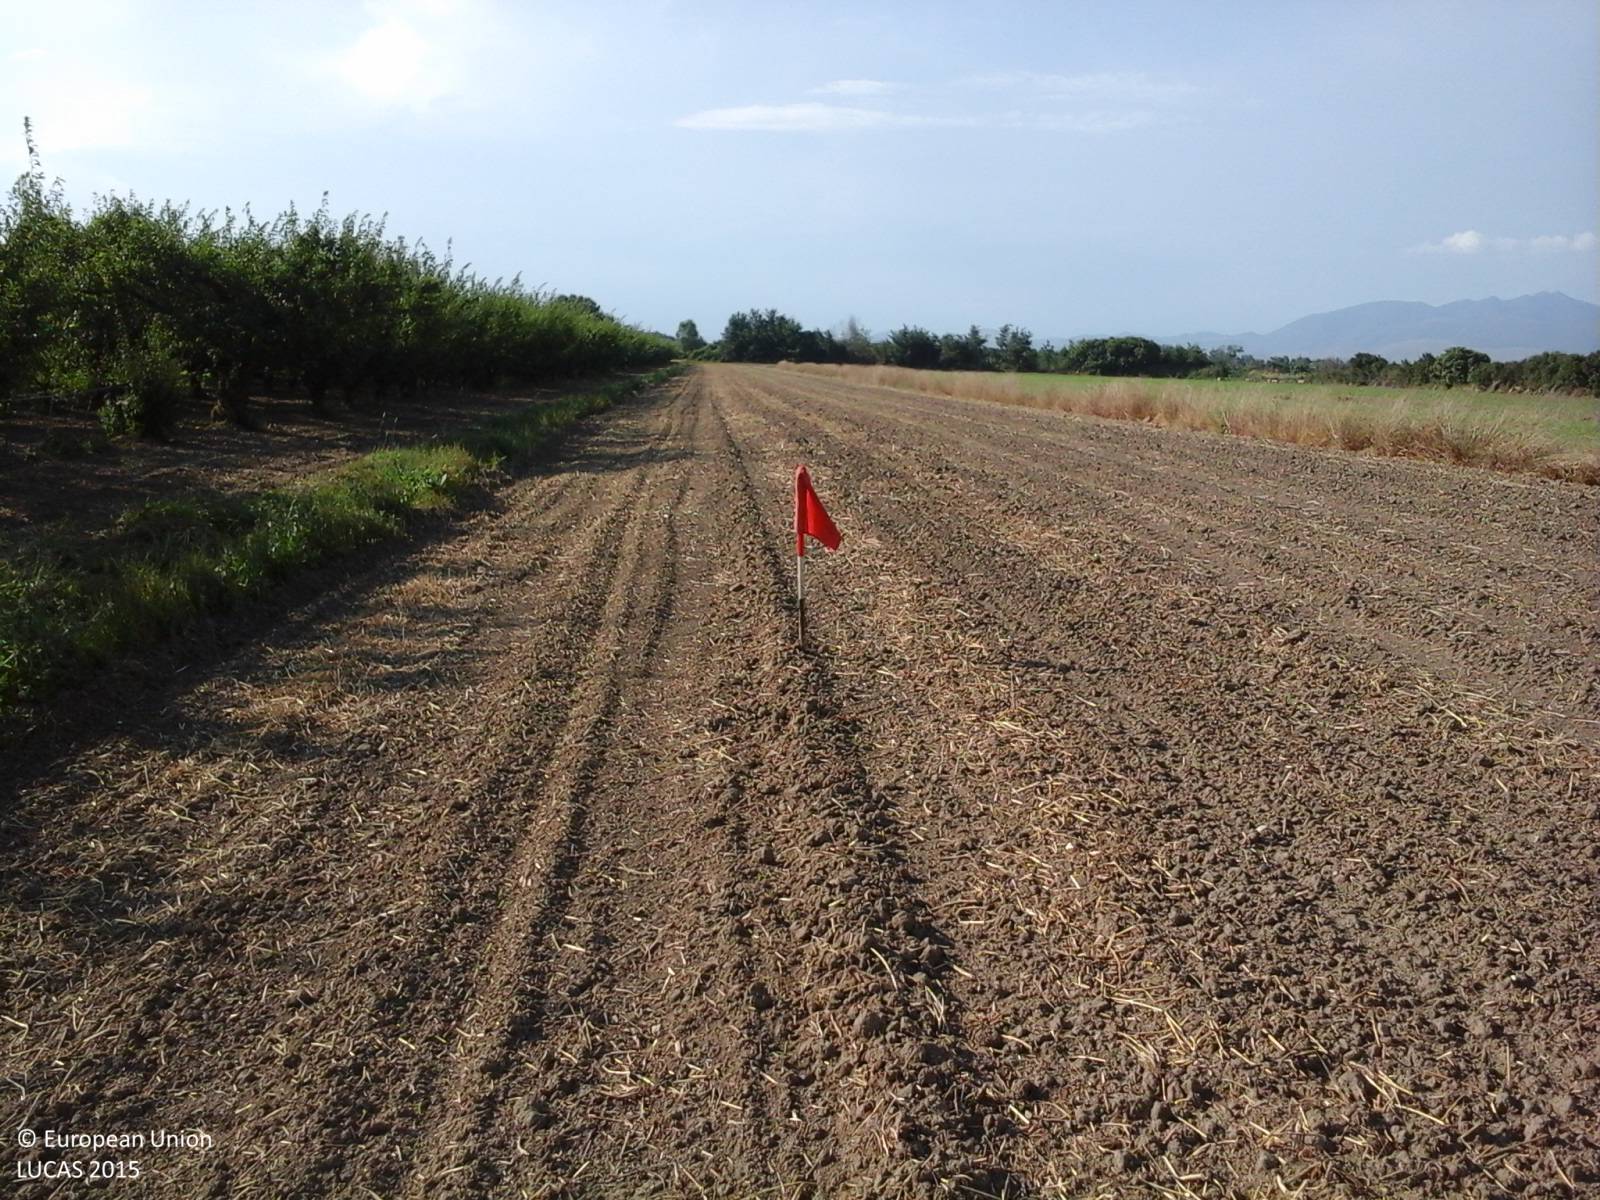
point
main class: Cropland
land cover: Temporary grasslands
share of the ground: < 10 %
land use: Agriculture (excluding fallow land and kitchen gardens)
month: June
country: IT
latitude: 41.0858
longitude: 14.1378
